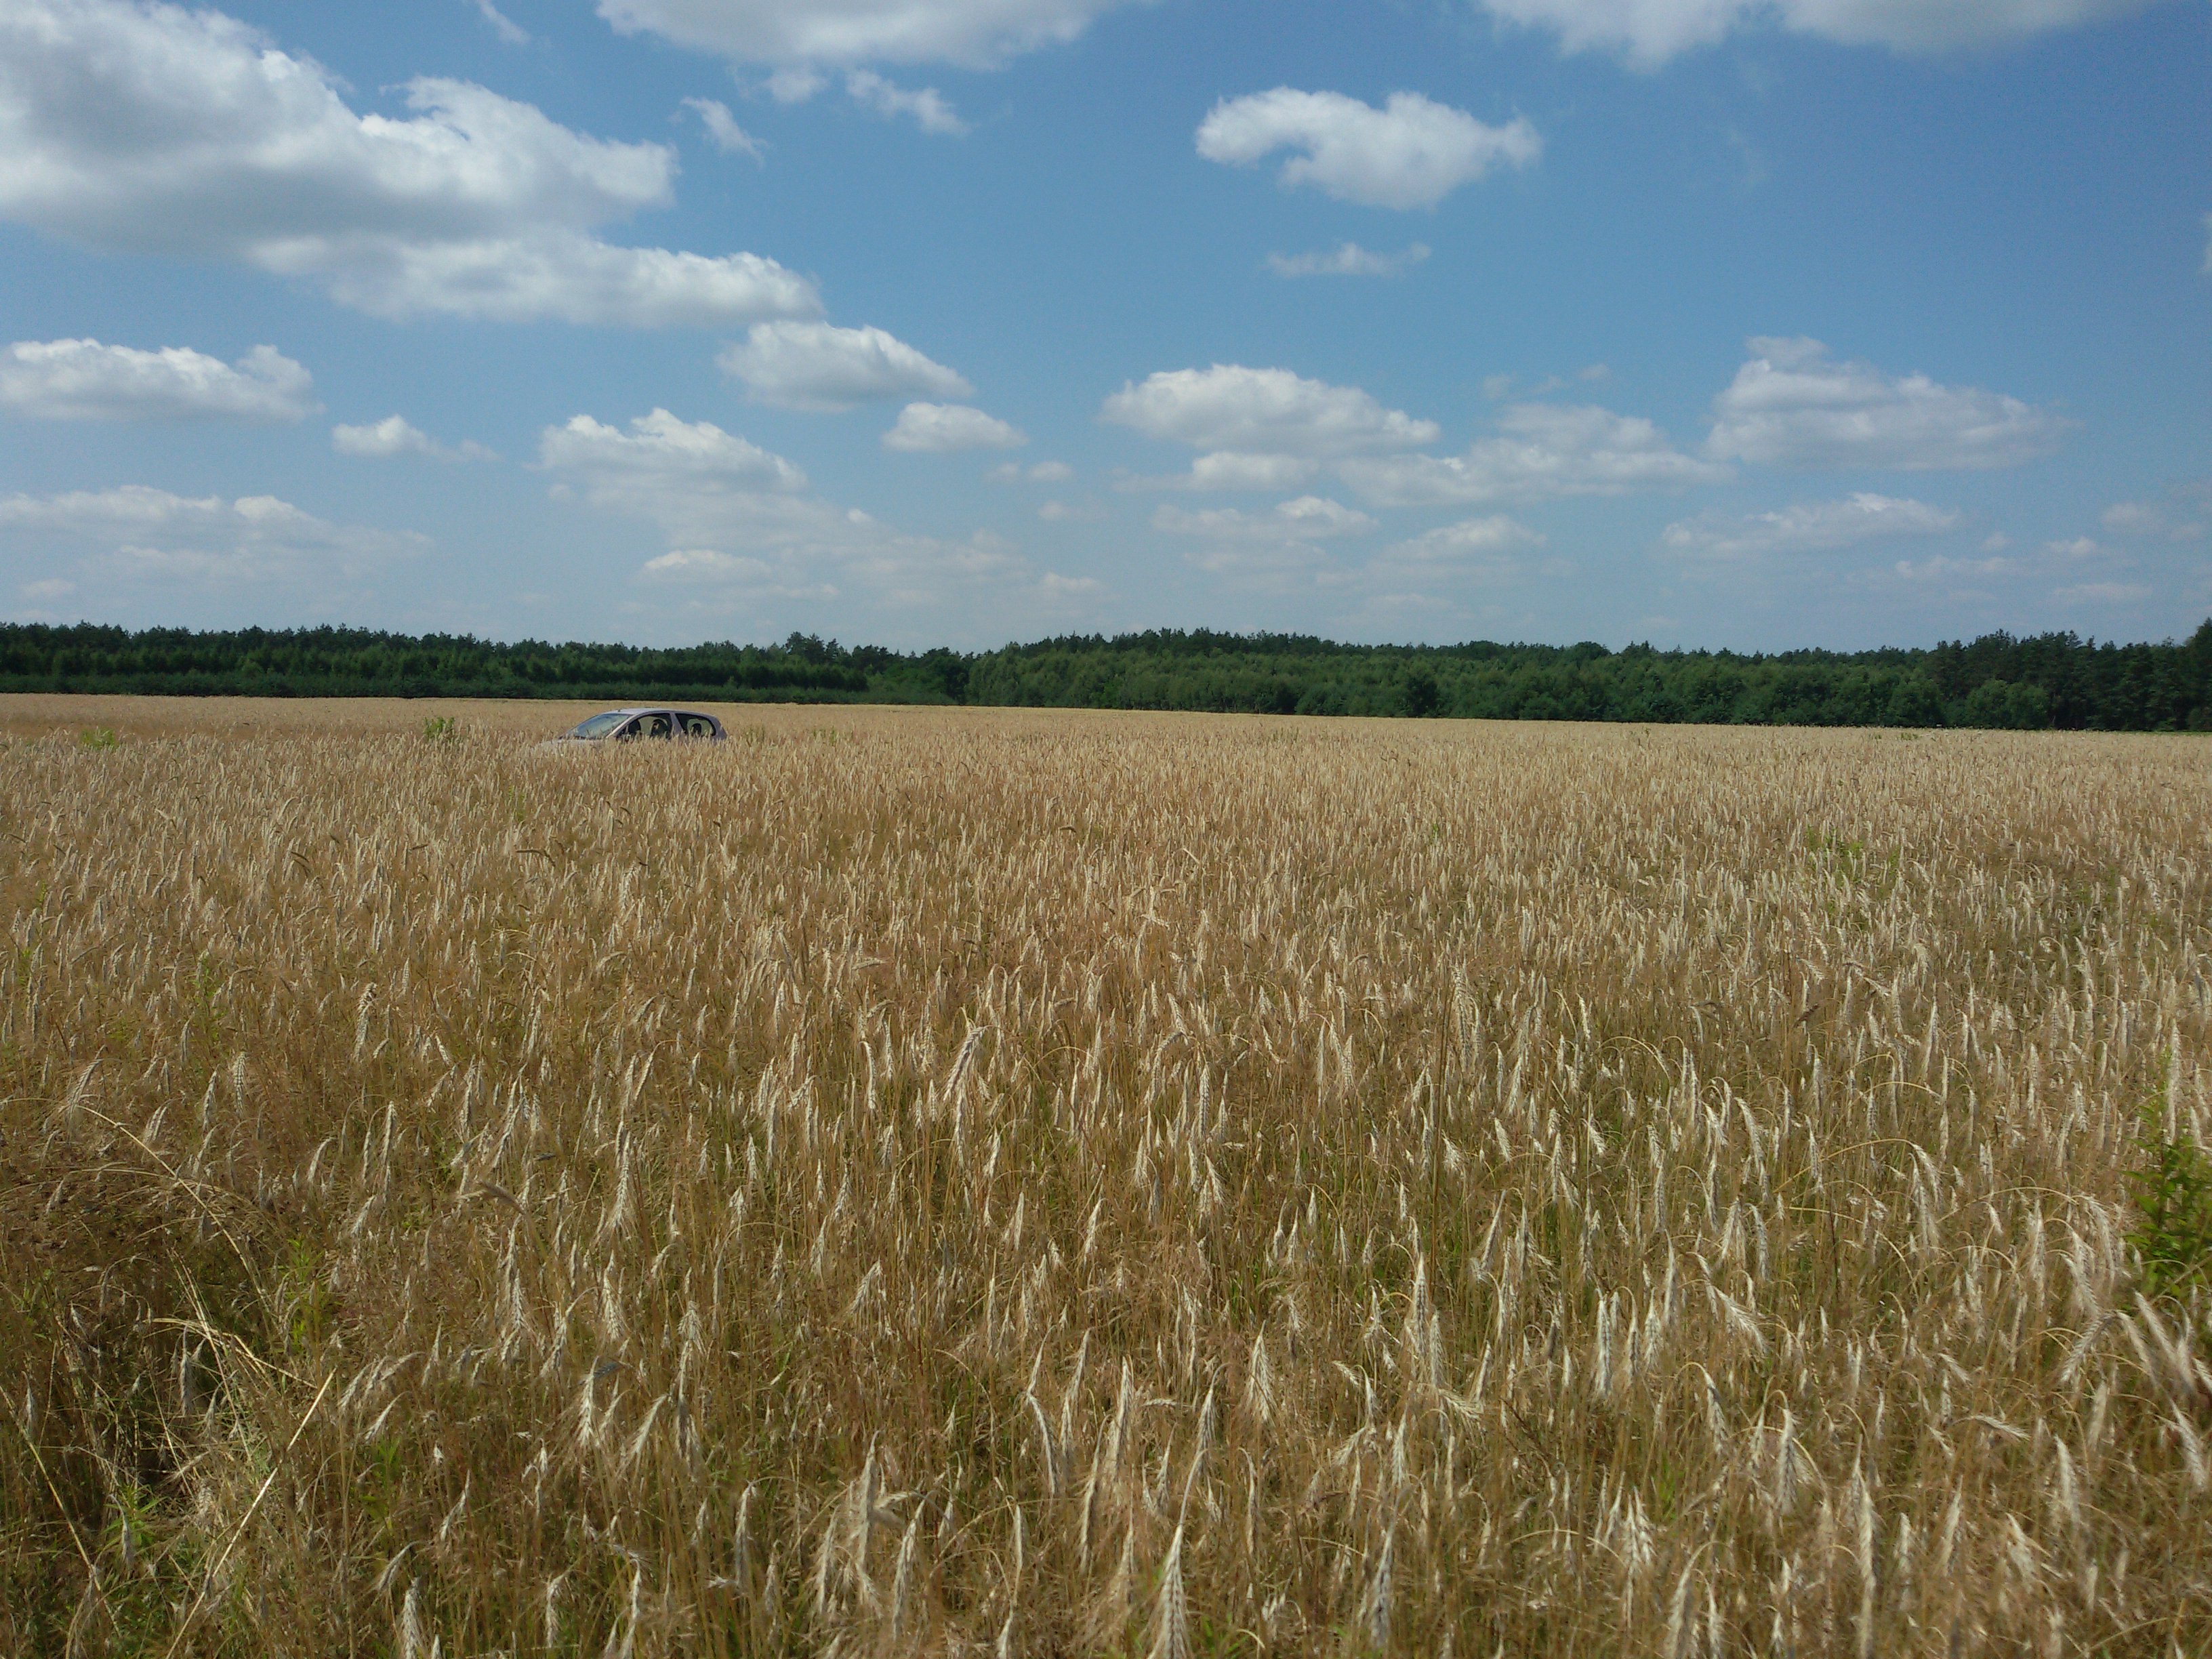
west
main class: Cropland
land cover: Rye
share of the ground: > 75 %
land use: Agriculture (excluding fallow land and kitchen gardens)
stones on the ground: < 10 %
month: July
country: PL
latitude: 50.2512
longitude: 22.3914
